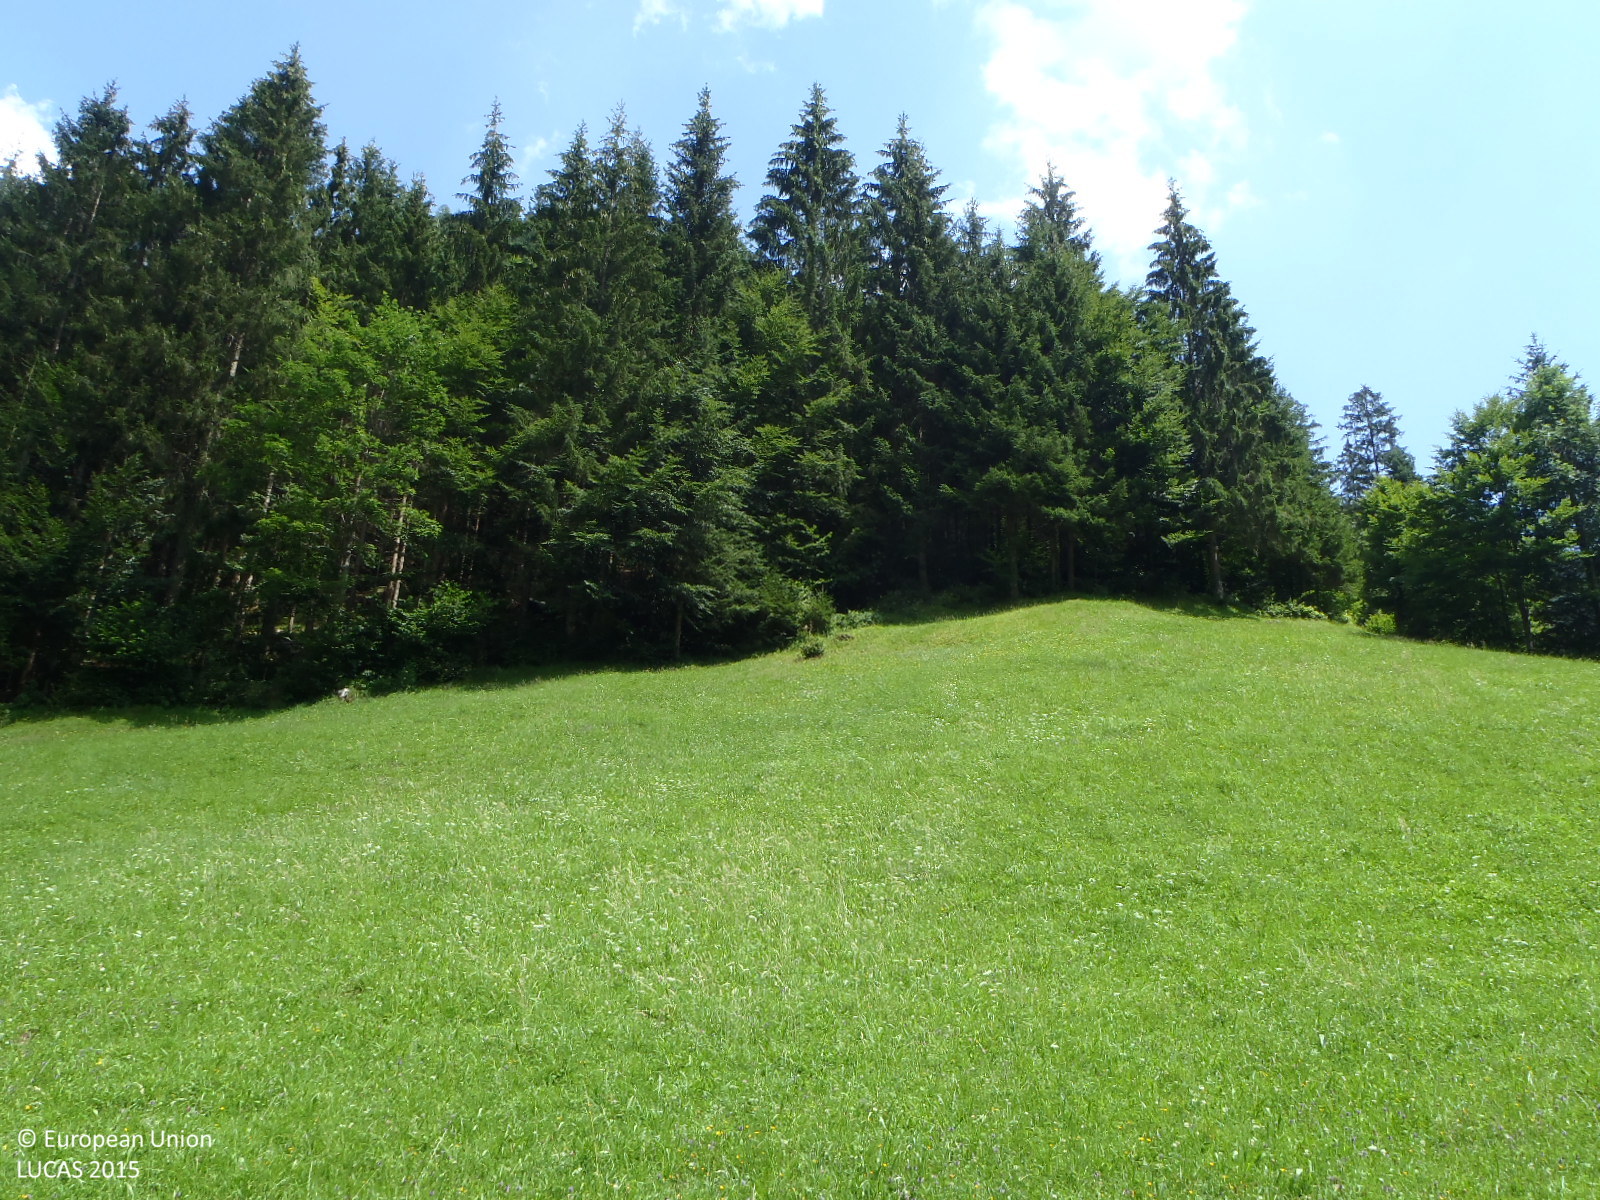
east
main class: Grassland
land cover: Grassland without tree/shrub cover
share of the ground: > 75 %
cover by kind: herbaceous plants 100 %
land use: Agriculture (excluding fallow land and kitchen gardens)
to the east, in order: Grassland without tree/shrub cover; Spruce dominated mixed woodland; Spruce dominated coniferous woodland; Dry stone walls; Tracks; Spruce dominated coniferous woodland; Spruce dominated mixed woodland; Spruce dominated coniferous woodland; Spruce dominated mixed woodland
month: July
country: AT
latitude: 47.5231
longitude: 11.8978
